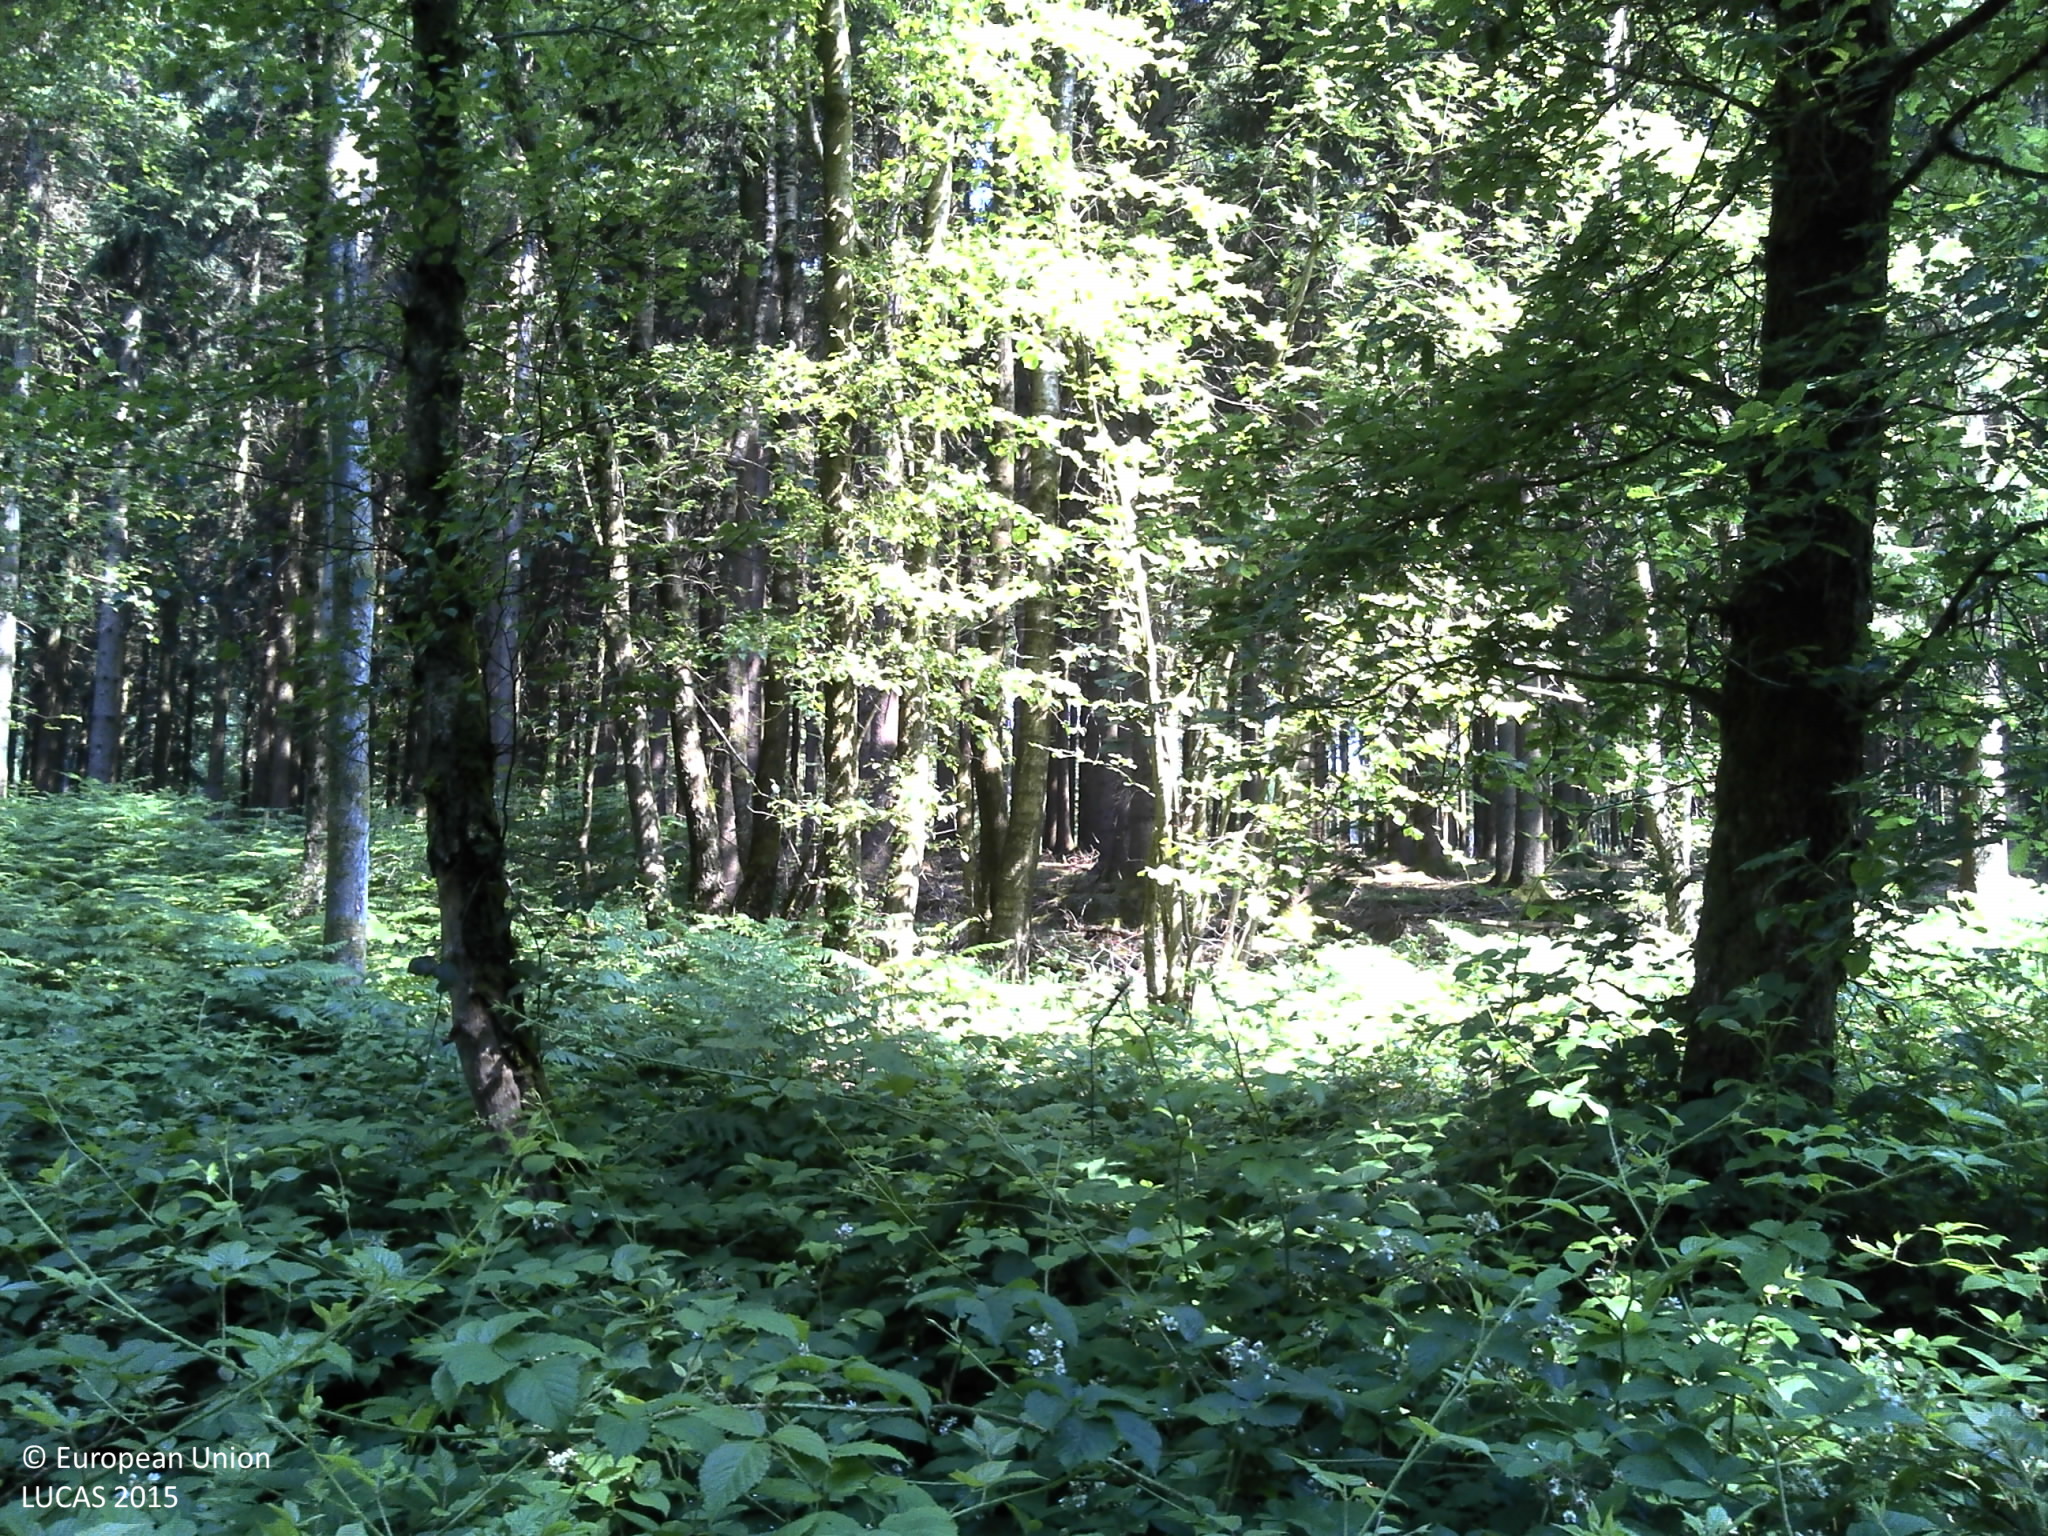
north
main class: Woodland
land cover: Spruce dominated coniferous woodland
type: alpine coniferous forest
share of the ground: 50 - 75 %
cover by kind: coniferous forest trees 70 %, herbaceous plants 20 %, lichens and mosses 10 %
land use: Forestry
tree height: > 5 m
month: July
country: FR
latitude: 49.9138
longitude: 4.6348
